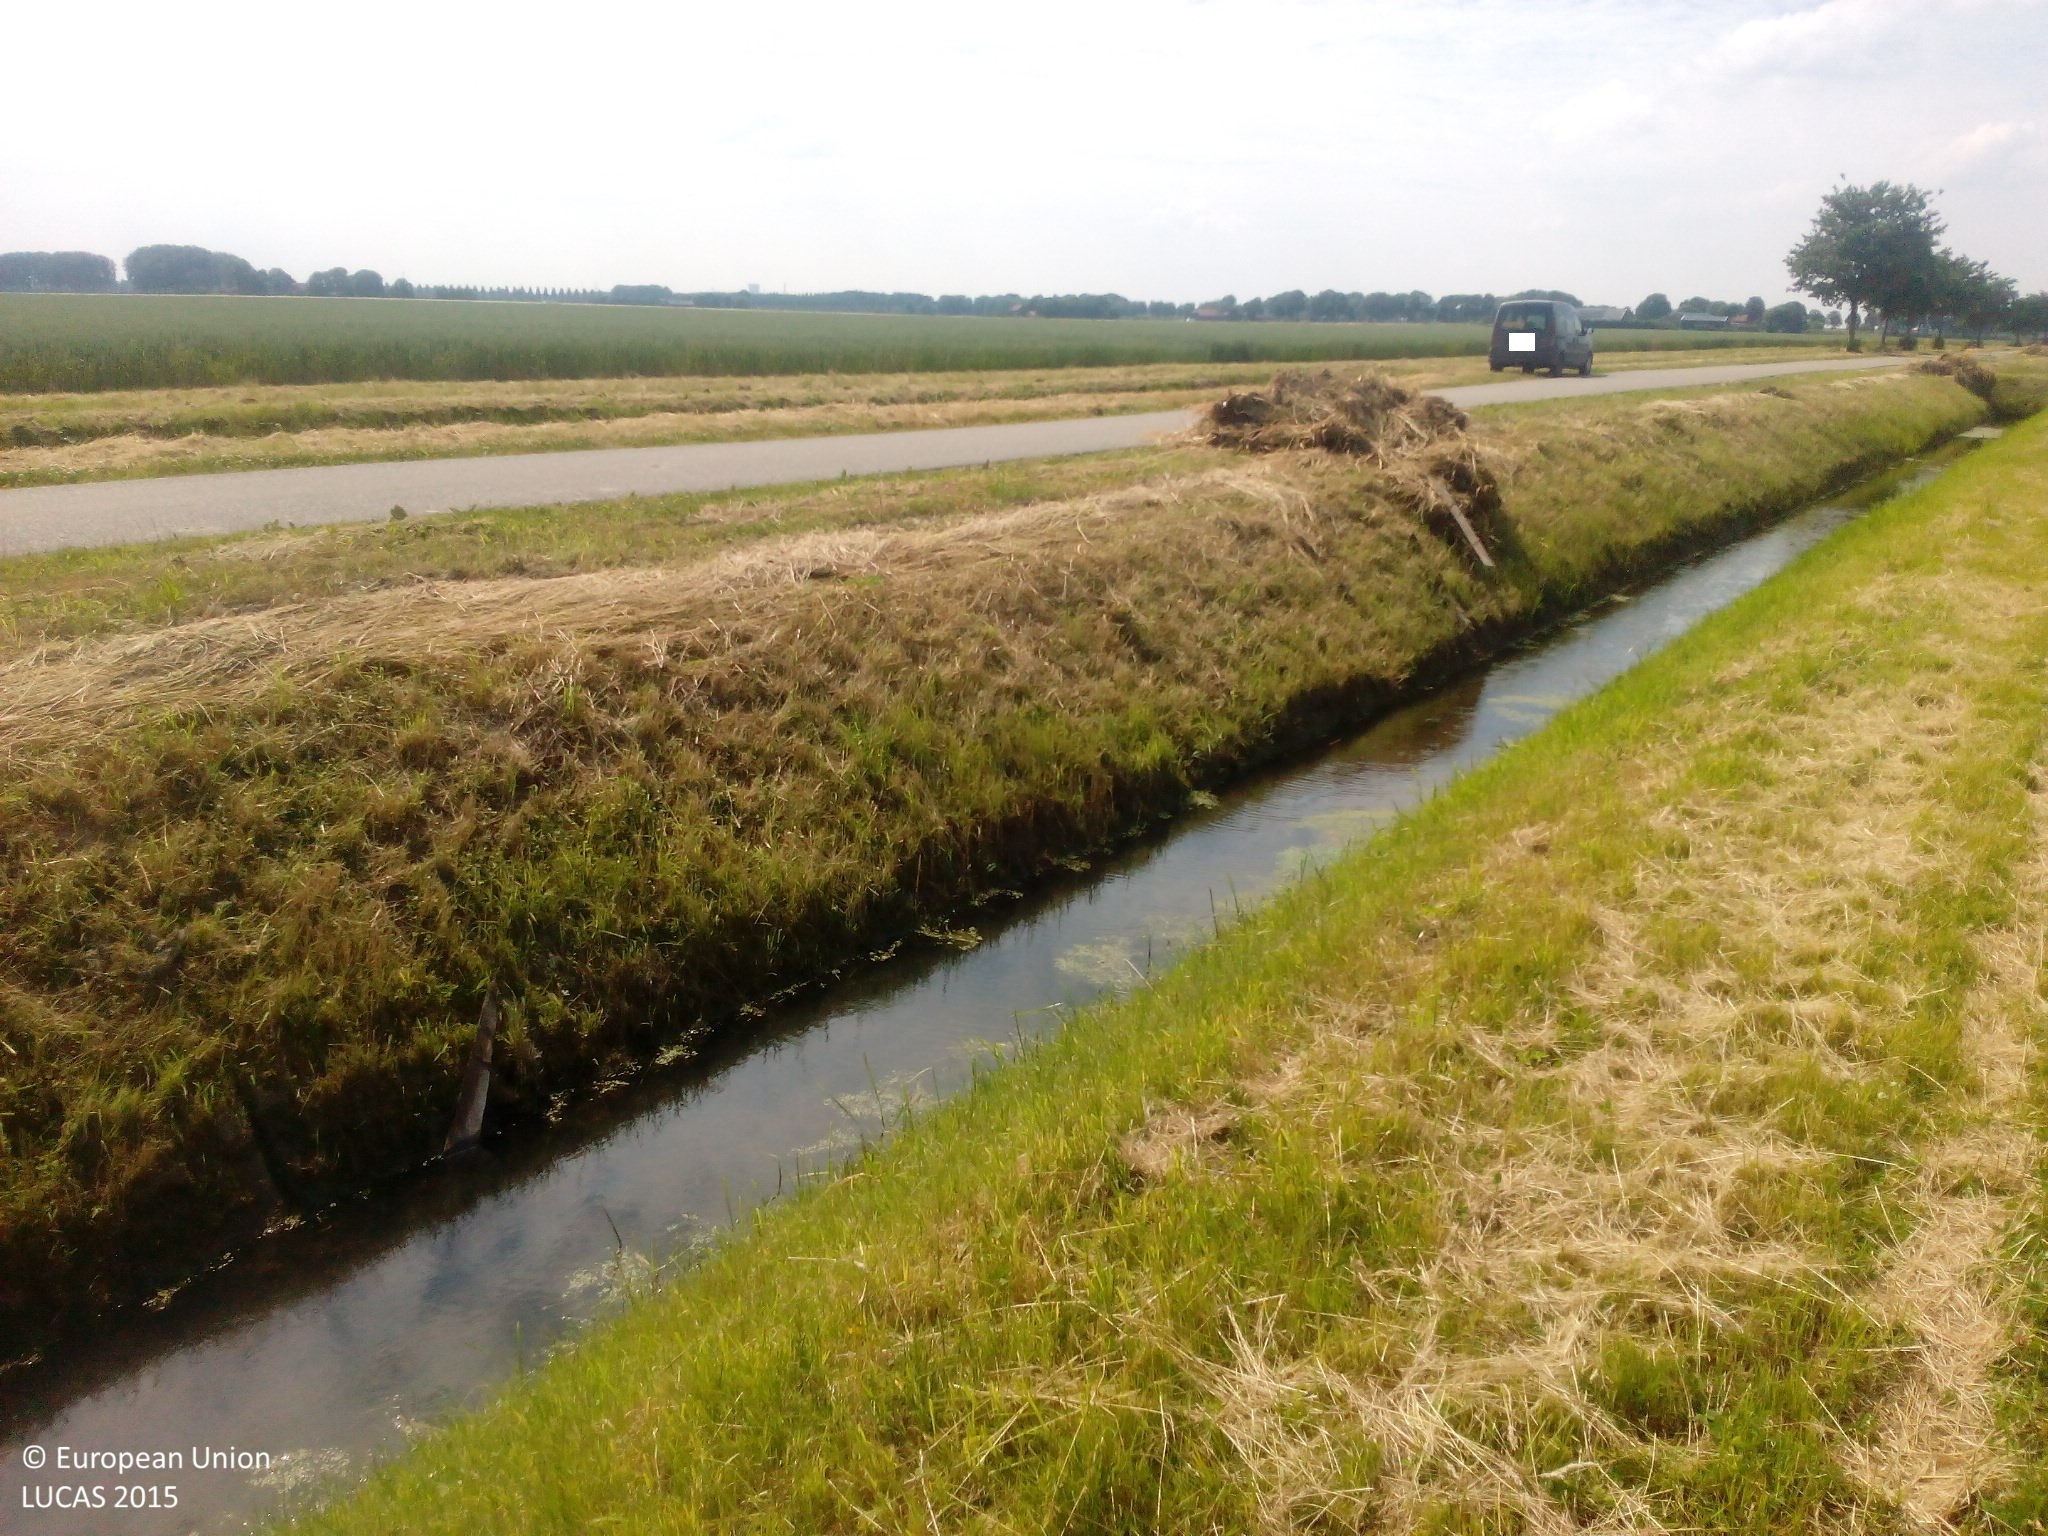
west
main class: Grassland
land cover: Grassland without tree/shrub cover
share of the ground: > 75 %
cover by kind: herbaceous plants 90 %, consolidated bare surface 10 %
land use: Agriculture (excluding fallow land and kitchen gardens)
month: June
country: NL
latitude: 51.7001
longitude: 4.6862
